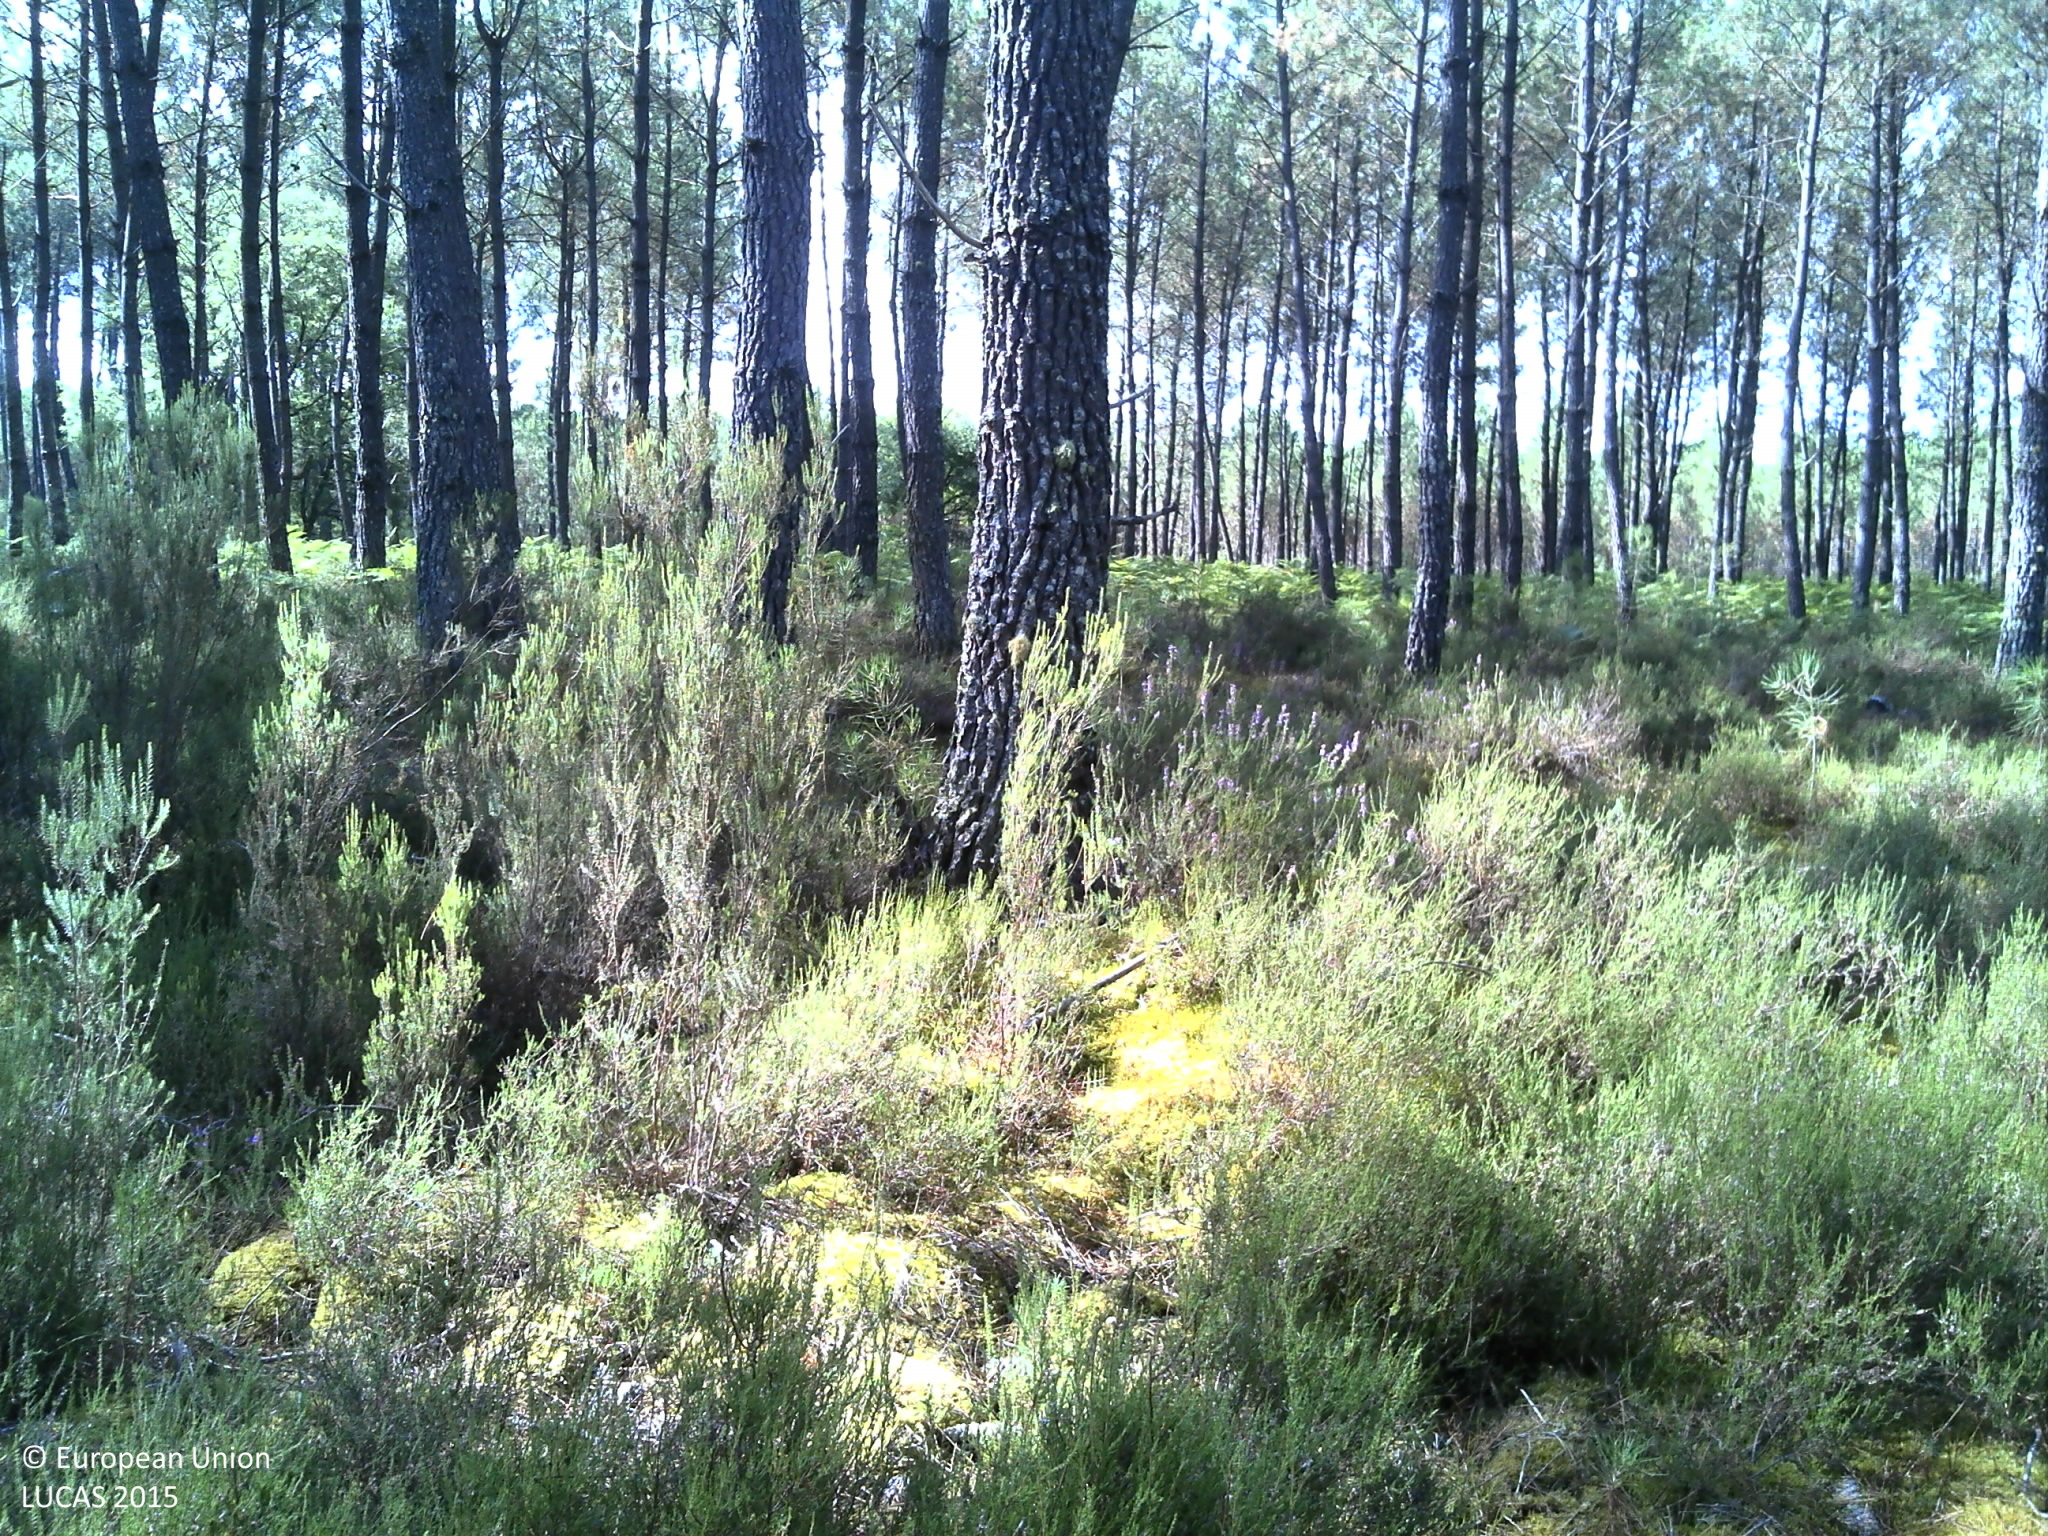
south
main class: Woodland
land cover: Pine dominated coniferous woodland
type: coniferous forest of the mediterranean region
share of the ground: > 75 %
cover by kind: coniferous forest trees 60 %, shrubs 30 %, herbaceous plants 5 %, lichens and mosses 5 %
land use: Forestry
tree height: > 5 m
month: July
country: FR
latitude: 44.4032
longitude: -0.4489
